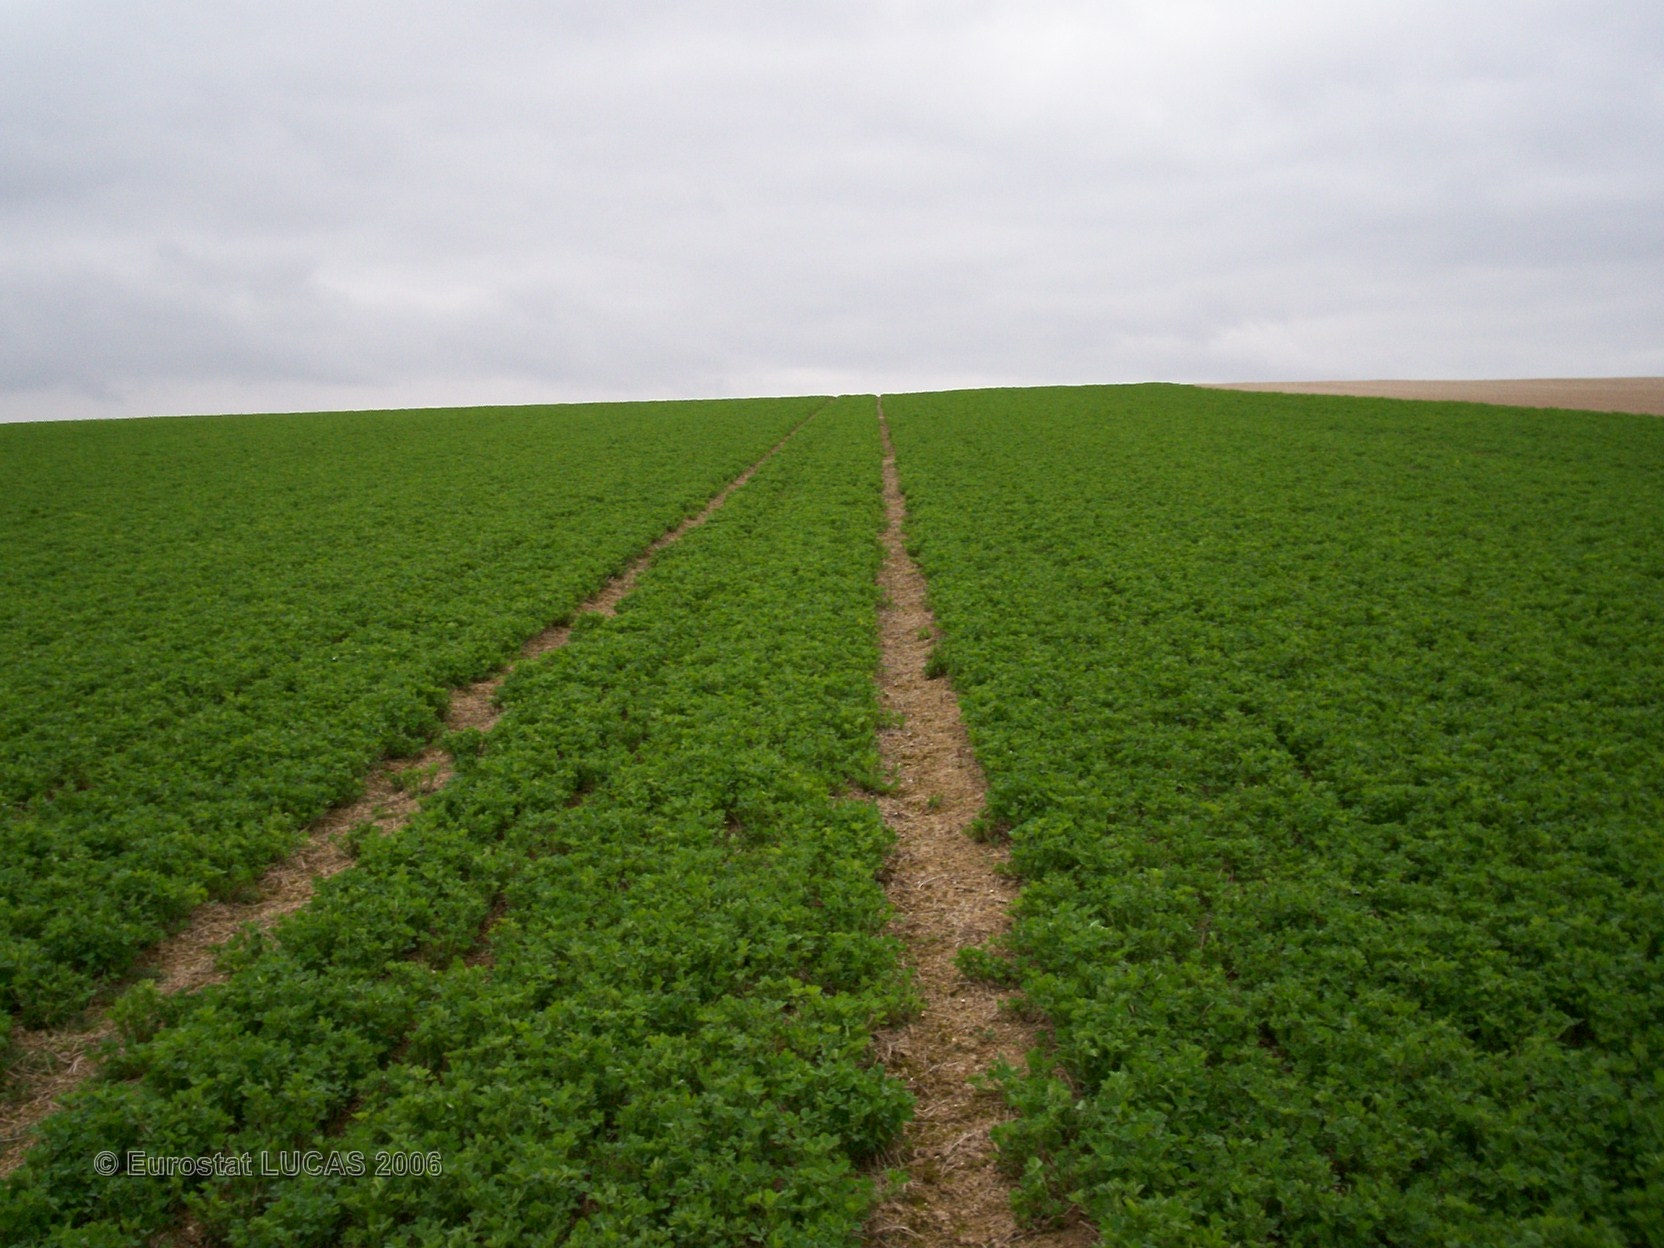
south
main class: Cropland
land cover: Lucerne
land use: Agriculture (excluding fallow land and kitchen gardens)
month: April
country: FR
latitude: 49.2371
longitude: 4.4339
